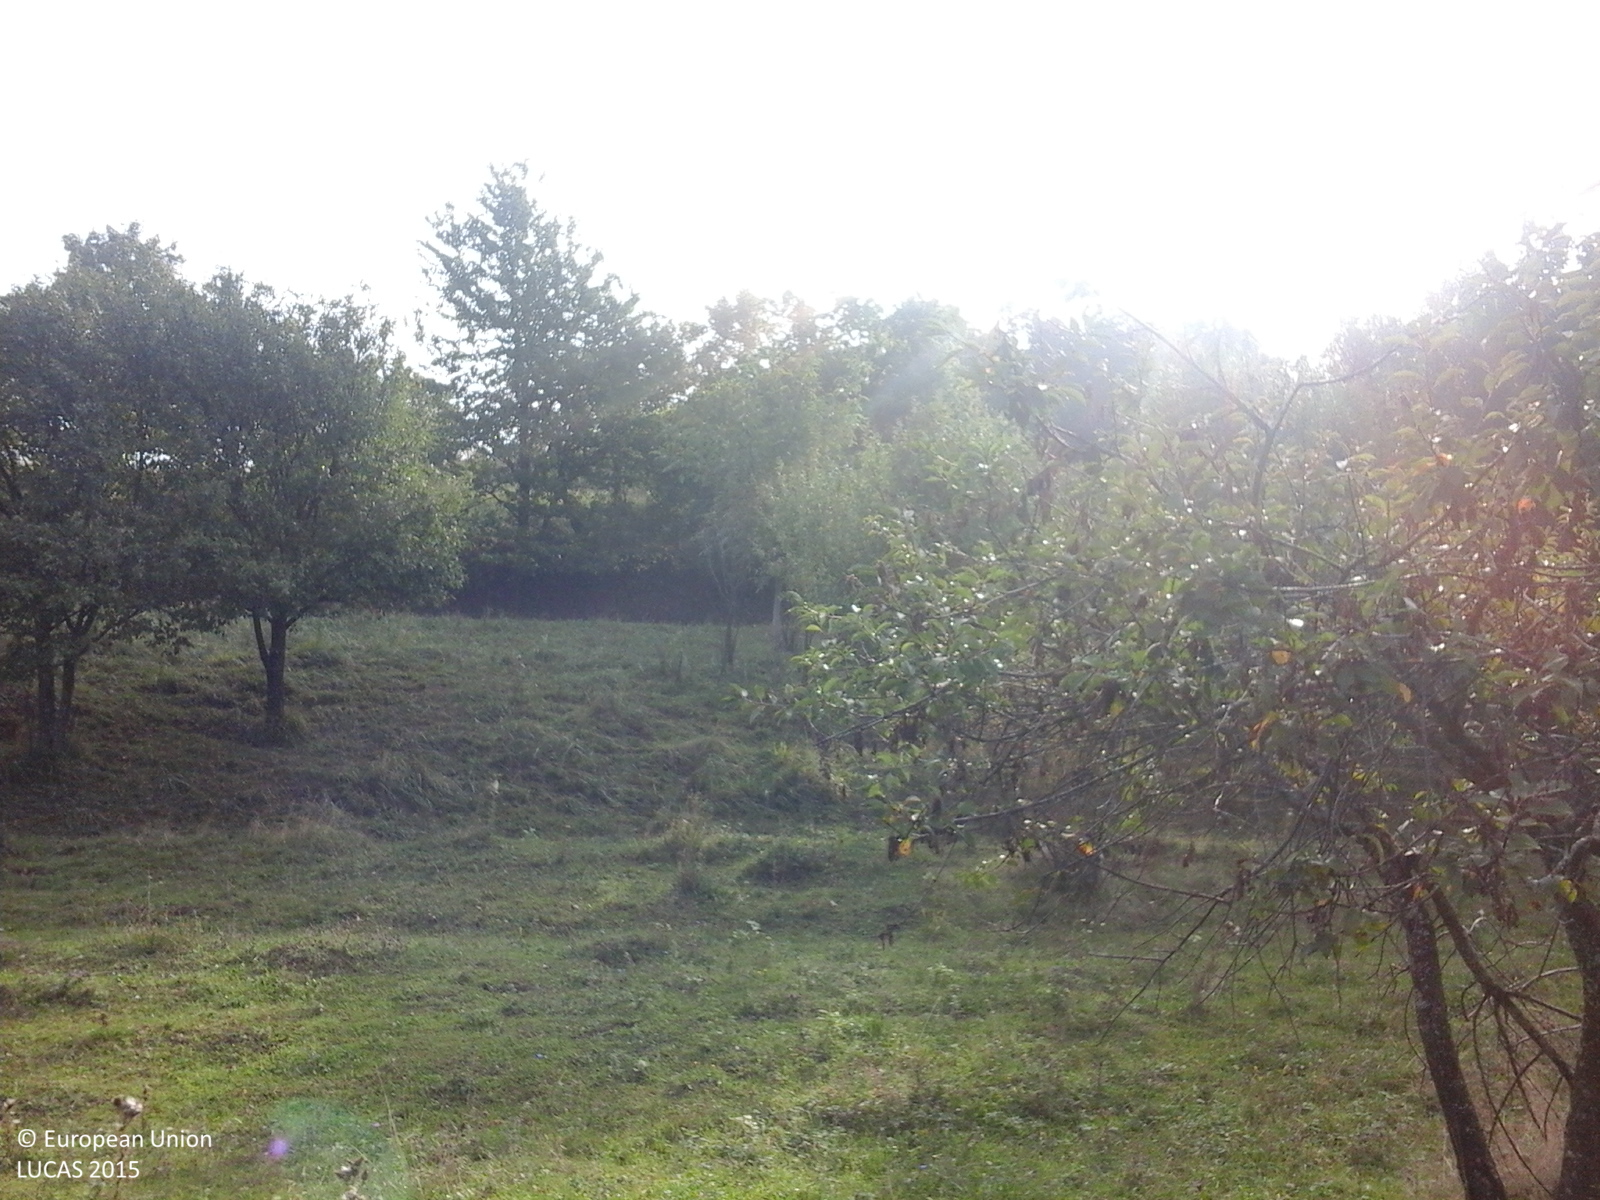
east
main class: Grassland
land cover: Grassland with sparse tree/shrub cover
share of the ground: > 75 %
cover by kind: herbaceous plants 85 %, shrubs 10 %, broadleaved forest trees 5 %
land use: Agriculture (excluding fallow land and kitchen gardens)
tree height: < 5 m
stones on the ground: < 10 %
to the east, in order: Grassland with sparse tree/shrub cover; Abandoned hedges; Grassland without tree/shrub cover; Abandoned hedges; Spontaneously vegetated surfaces; Paved roads, cycling and walking lanes; Electric lines; Shruby margins; Broadleaved woodland
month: September
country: RO
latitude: 46.8800
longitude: 23.0397
